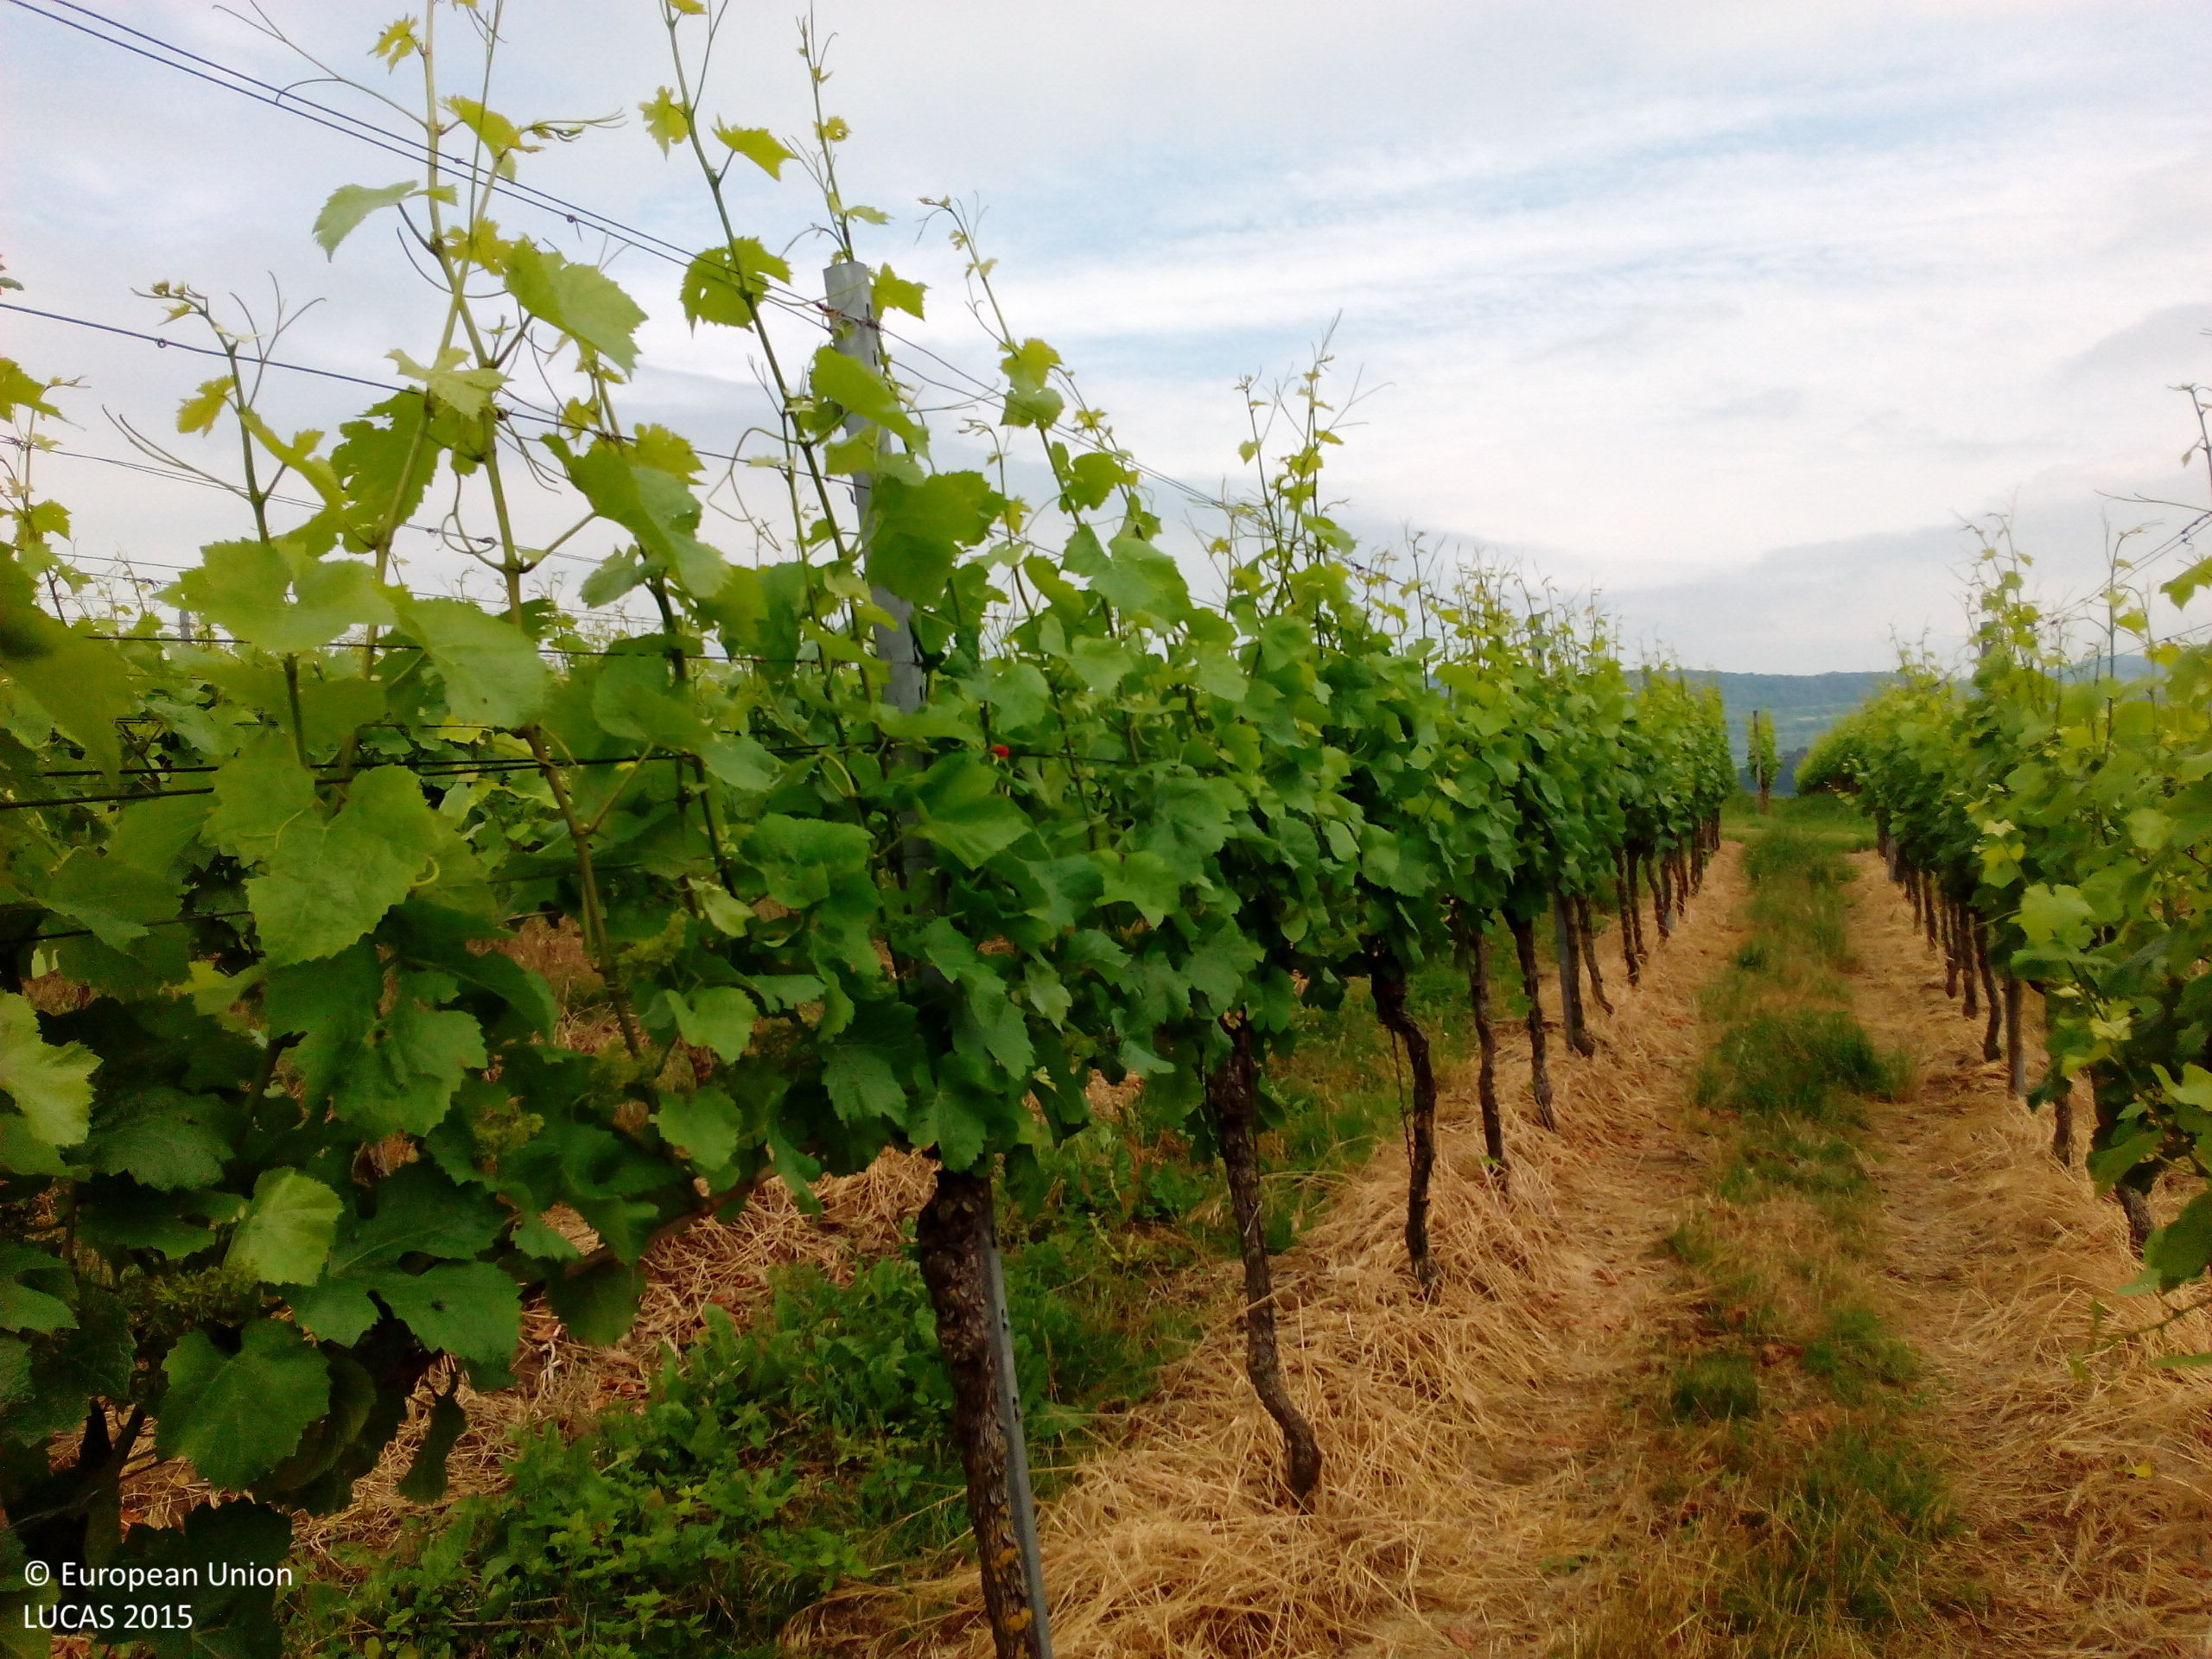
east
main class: Cropland
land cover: Vineyards
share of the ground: 25 - 50 %
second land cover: Grassland without tree/shrub cover
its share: 50 - 75 %
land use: Agriculture (excluding fallow land and kitchen gardens)
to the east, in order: Vineyards; Grassland without tree/shrub cover; Paved roads, cycling and walking lanes; Grass margins; Vineyards; Grassland without tree/shrub cover; Vineyards; Shruby margins; Vineyards; Broadleaved woodland; Vineyards; Shruby margins; Vineyards; Broadleaved woodland; Grassland with sparse tree/shrub cover
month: June
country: DE
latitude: 48.1074
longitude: 7.5971
